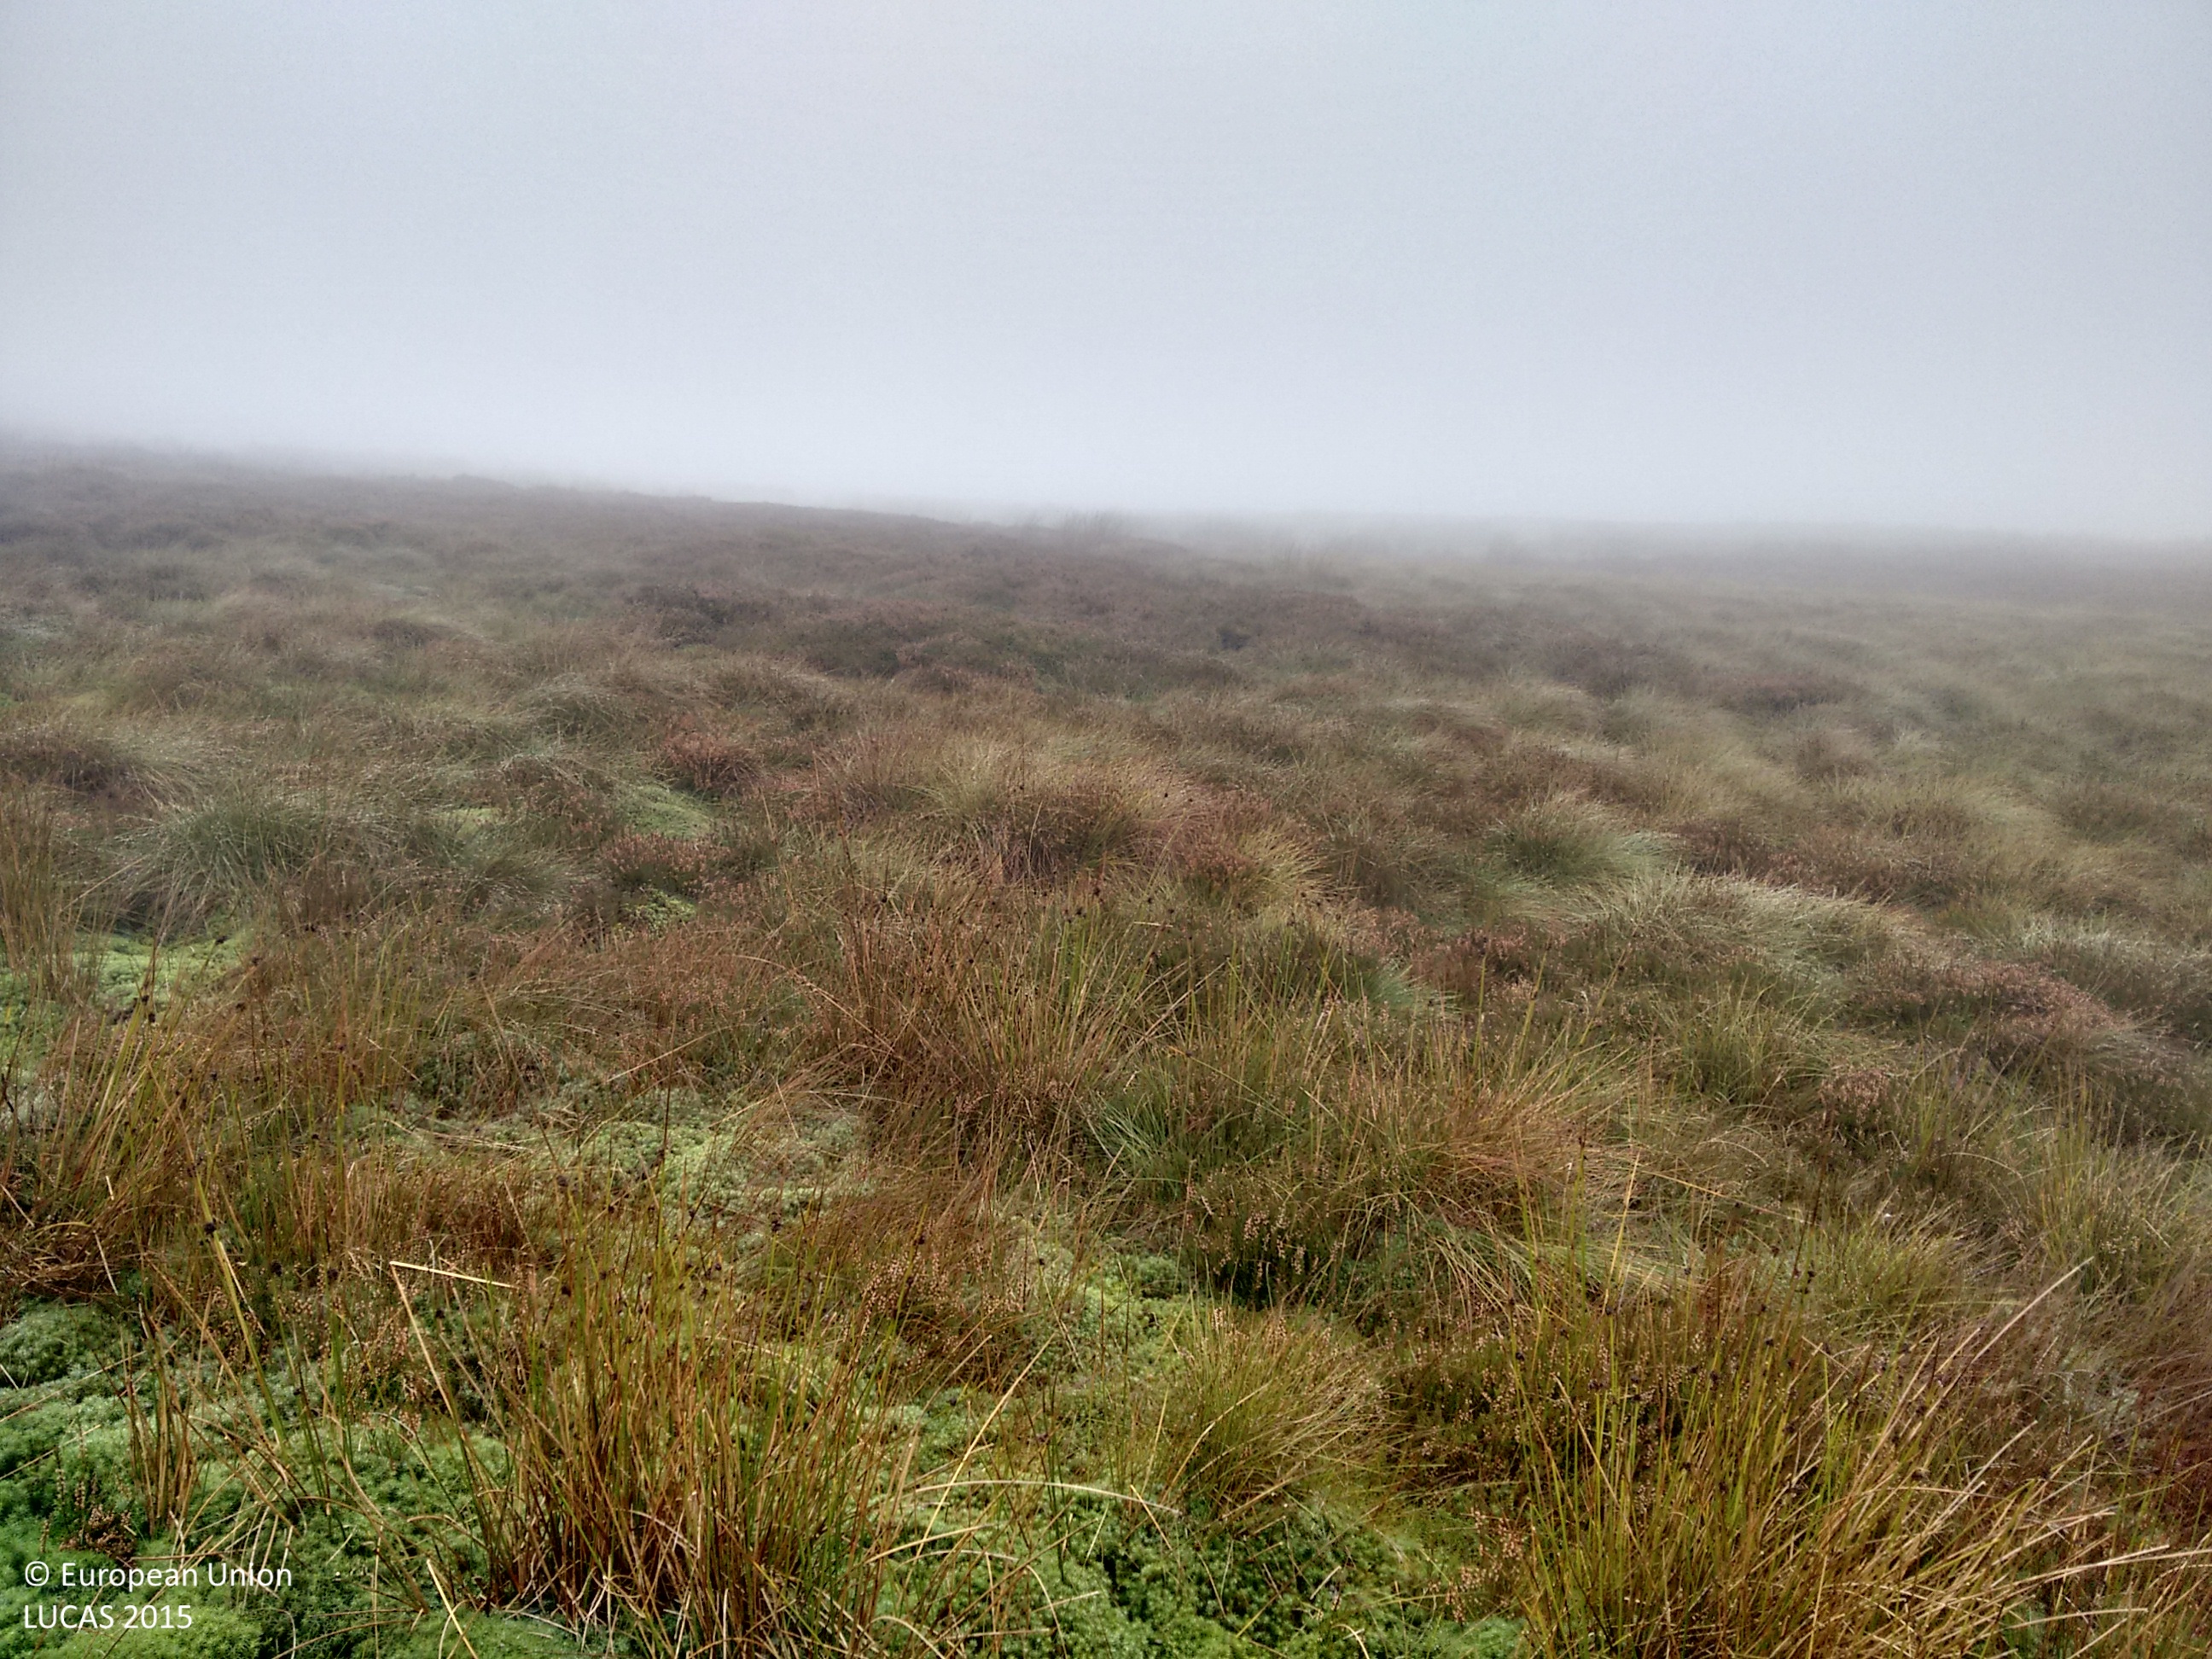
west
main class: Shrubland
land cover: Shrubland without tree cover
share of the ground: > 75 %
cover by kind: shrubs 80 %, herbaceous plants 20 %
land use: Semi-natural and natural areas not in use
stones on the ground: < 10 %
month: October
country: GB
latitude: 54.4654
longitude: -2.1071
